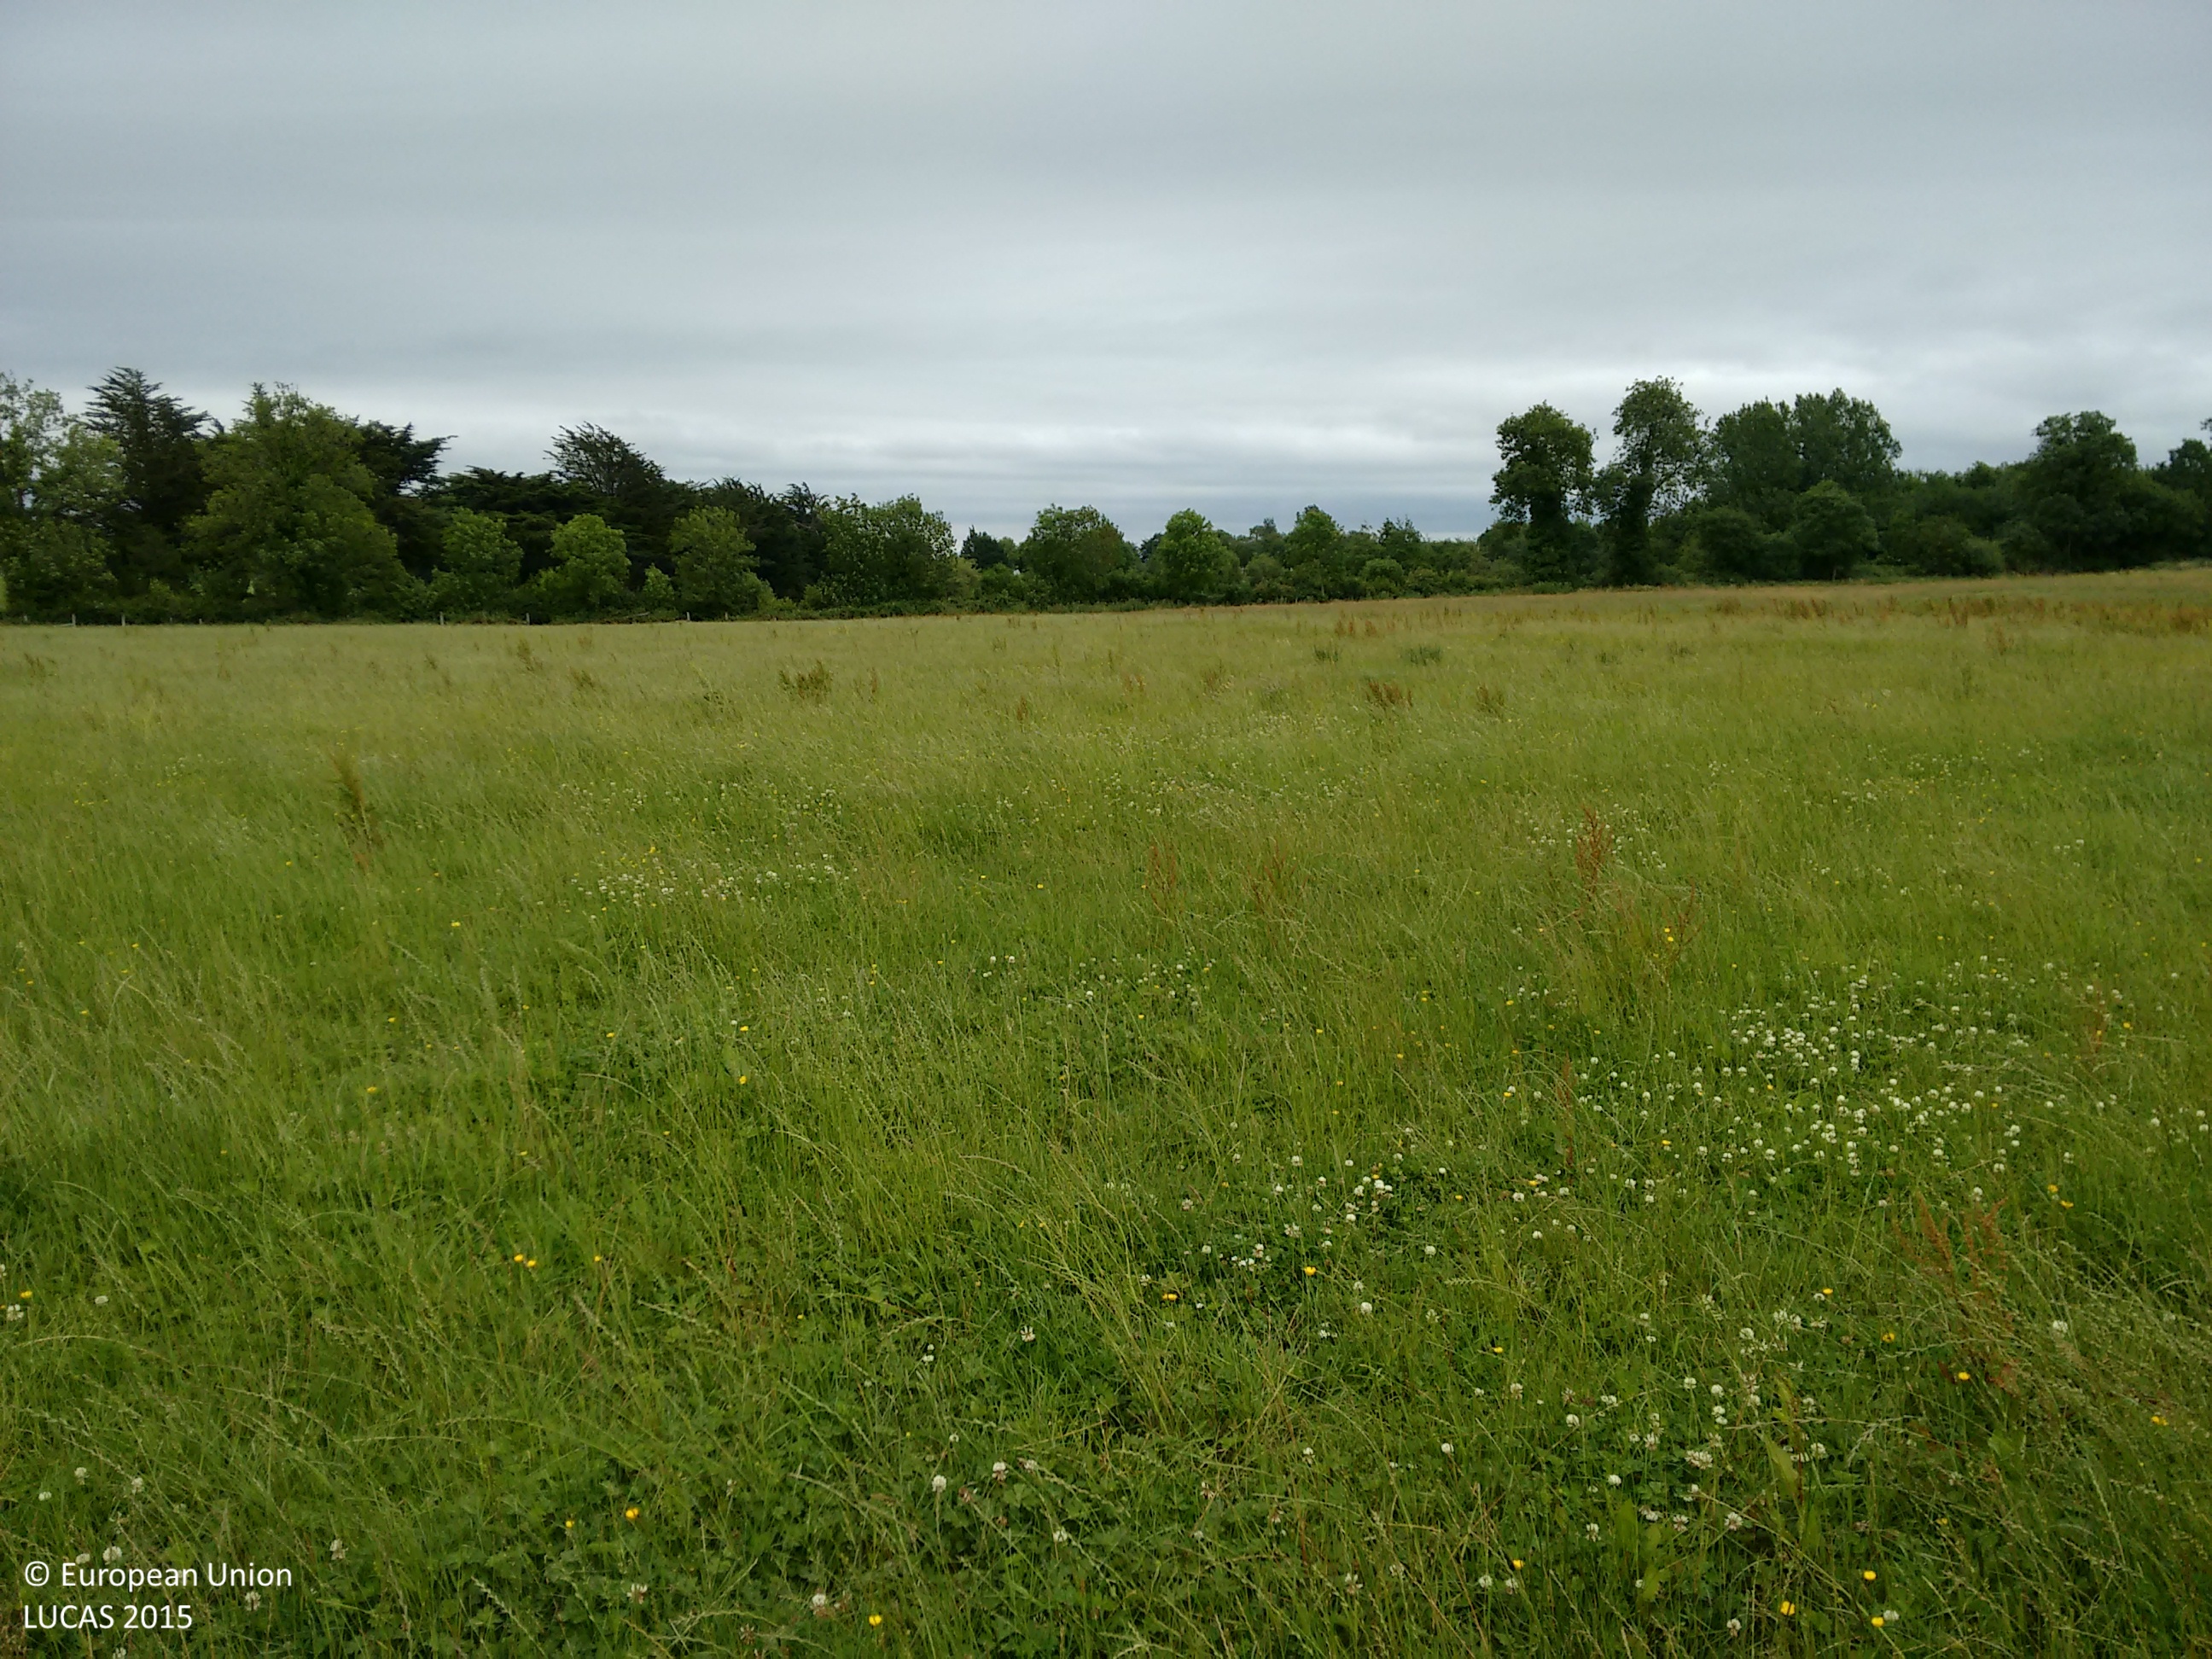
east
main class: Grassland
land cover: Grassland without tree/shrub cover
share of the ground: > 75 %
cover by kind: herbaceous plants 100 %
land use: Agriculture (excluding fallow land and kitchen gardens)
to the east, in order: Grassland without tree/shrub cover; Fences; Ditches and canals; Abandoned hedges; Grassland without tree/shrub cover; Inland marshes; Grassland without tree/shrub cover
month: July
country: IE
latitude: 52.4989
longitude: -8.2289
